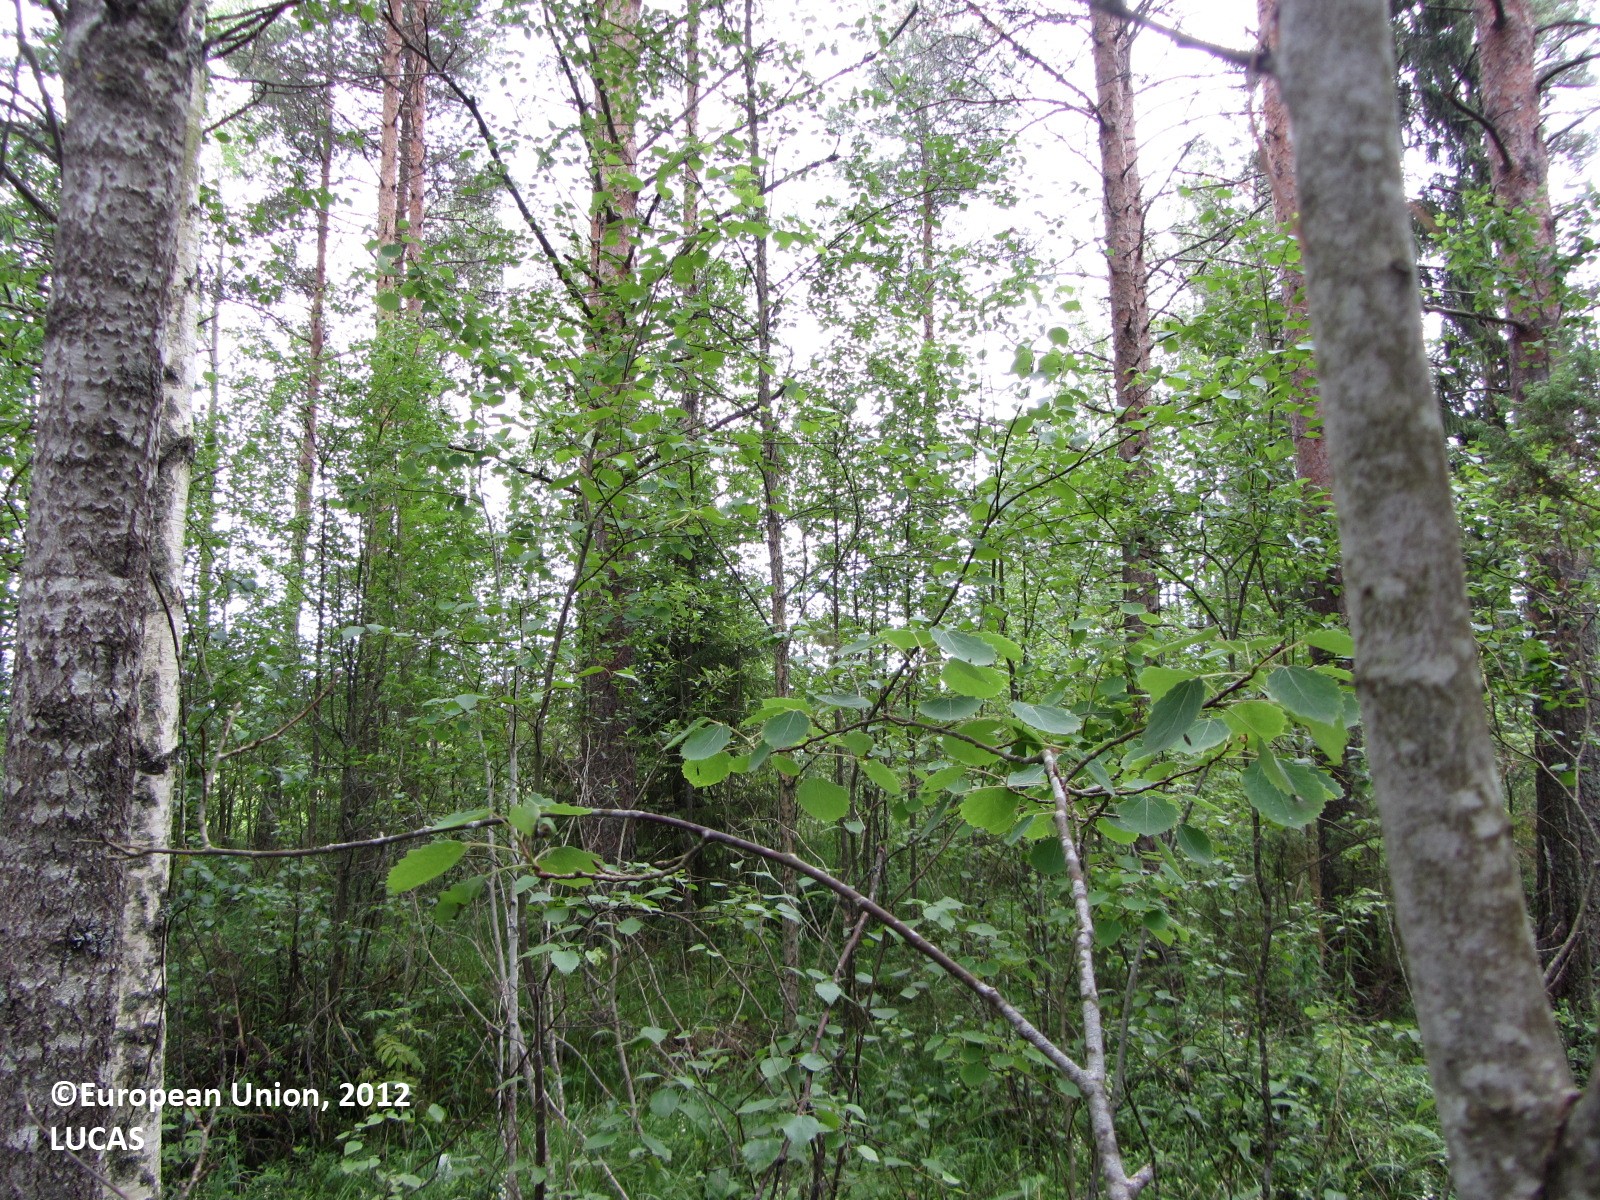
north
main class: Woodland
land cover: Pine dominated mixed woodland
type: boreal forest
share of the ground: > 75 %
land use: Forestry
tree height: > 5 m
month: July
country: FI
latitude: 63.7391
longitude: 25.5149
